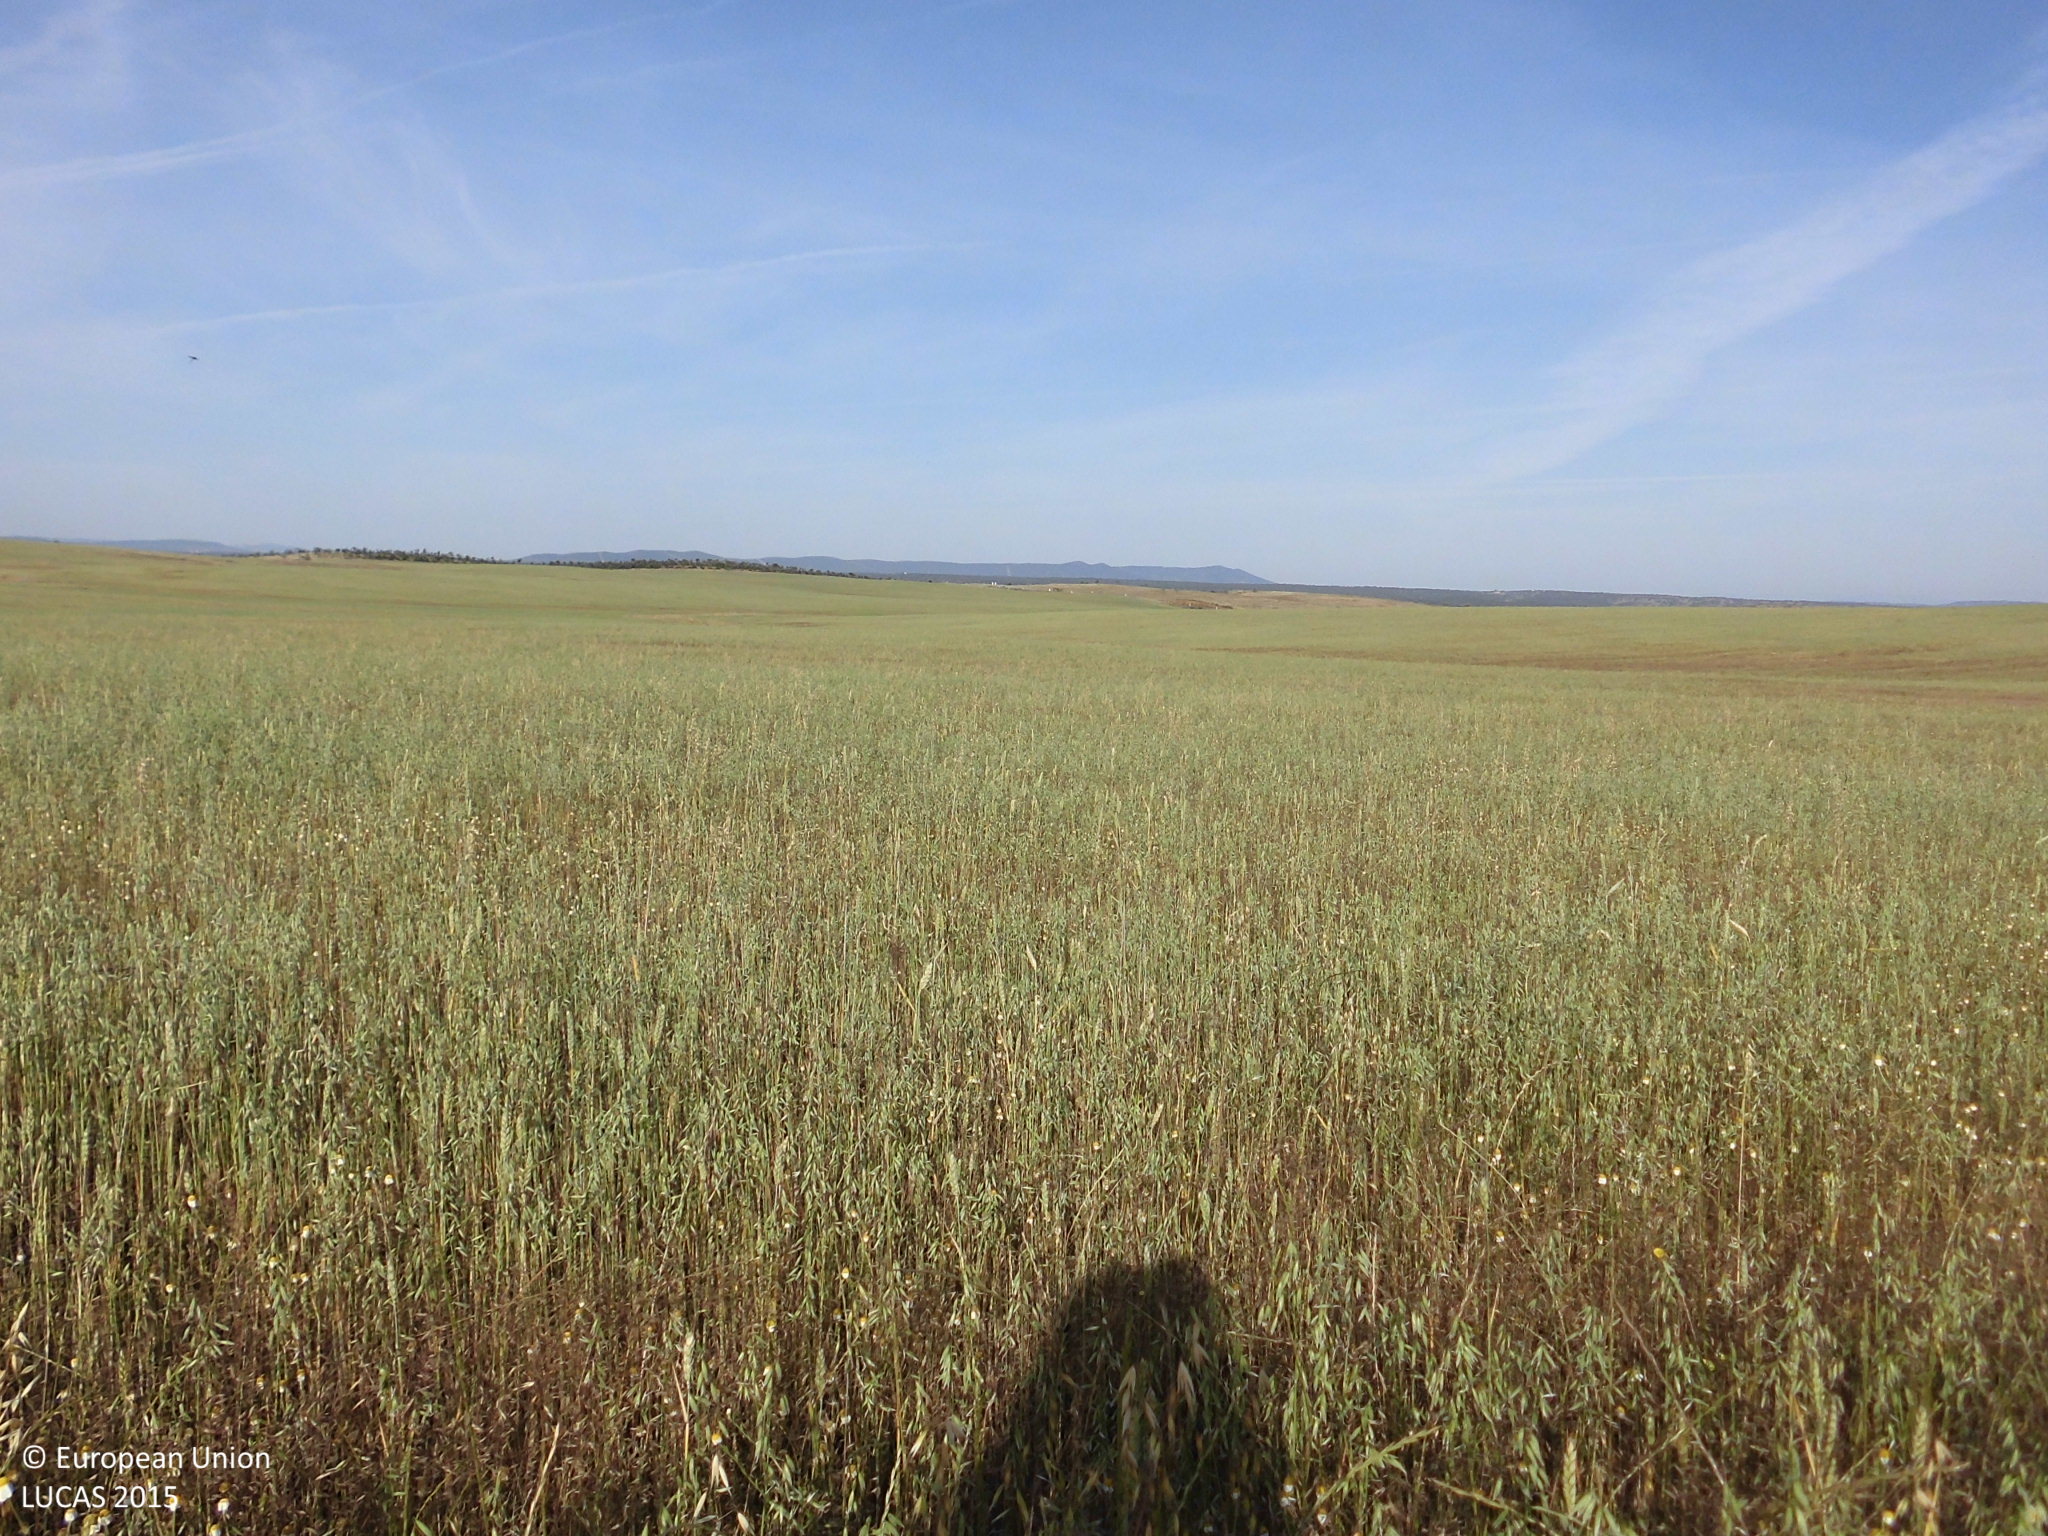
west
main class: Cropland
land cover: Oats
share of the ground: > 75 %
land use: Agriculture (excluding fallow land and kitchen gardens)
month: May
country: ES
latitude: 39.6084
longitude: -6.9593
